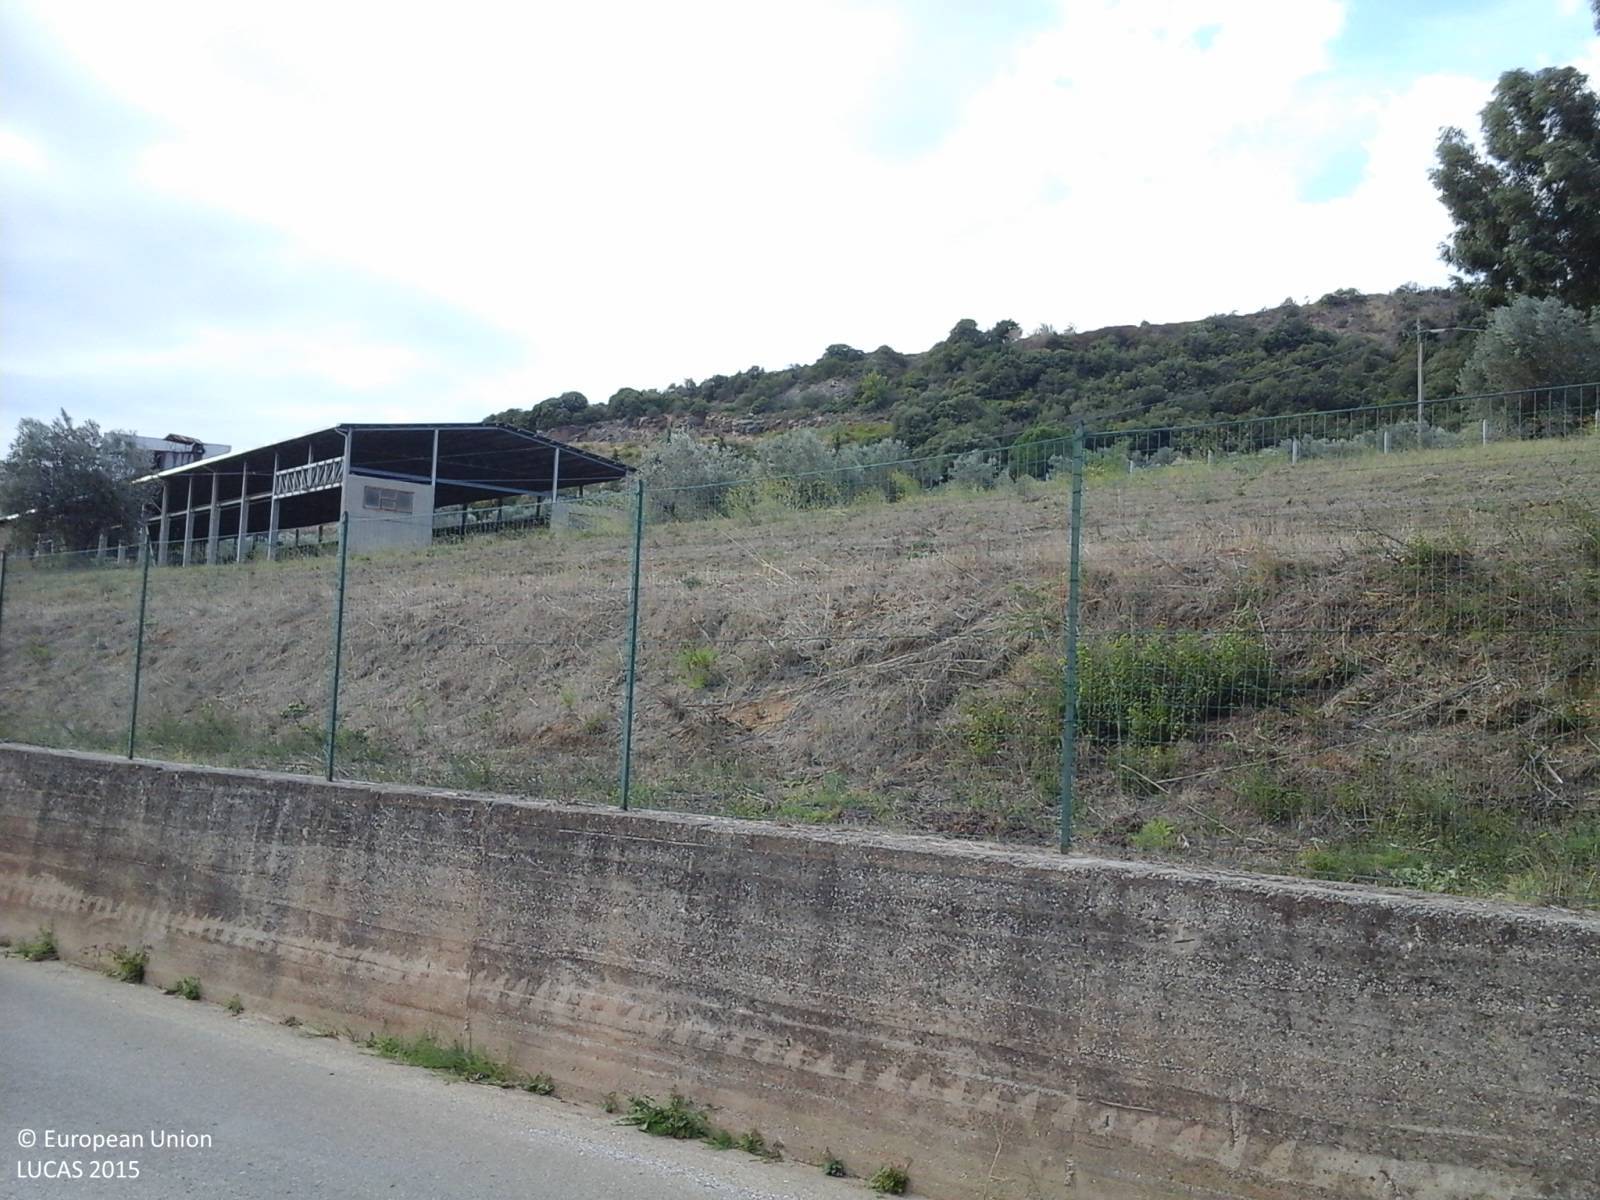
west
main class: Grassland
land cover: Grassland without tree/shrub cover
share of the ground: 50 - 75 %
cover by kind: herbaceous plants 100 %
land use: Agriculture (excluding fallow land and kitchen gardens)
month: September
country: IT
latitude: 43.0495
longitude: 10.5997
